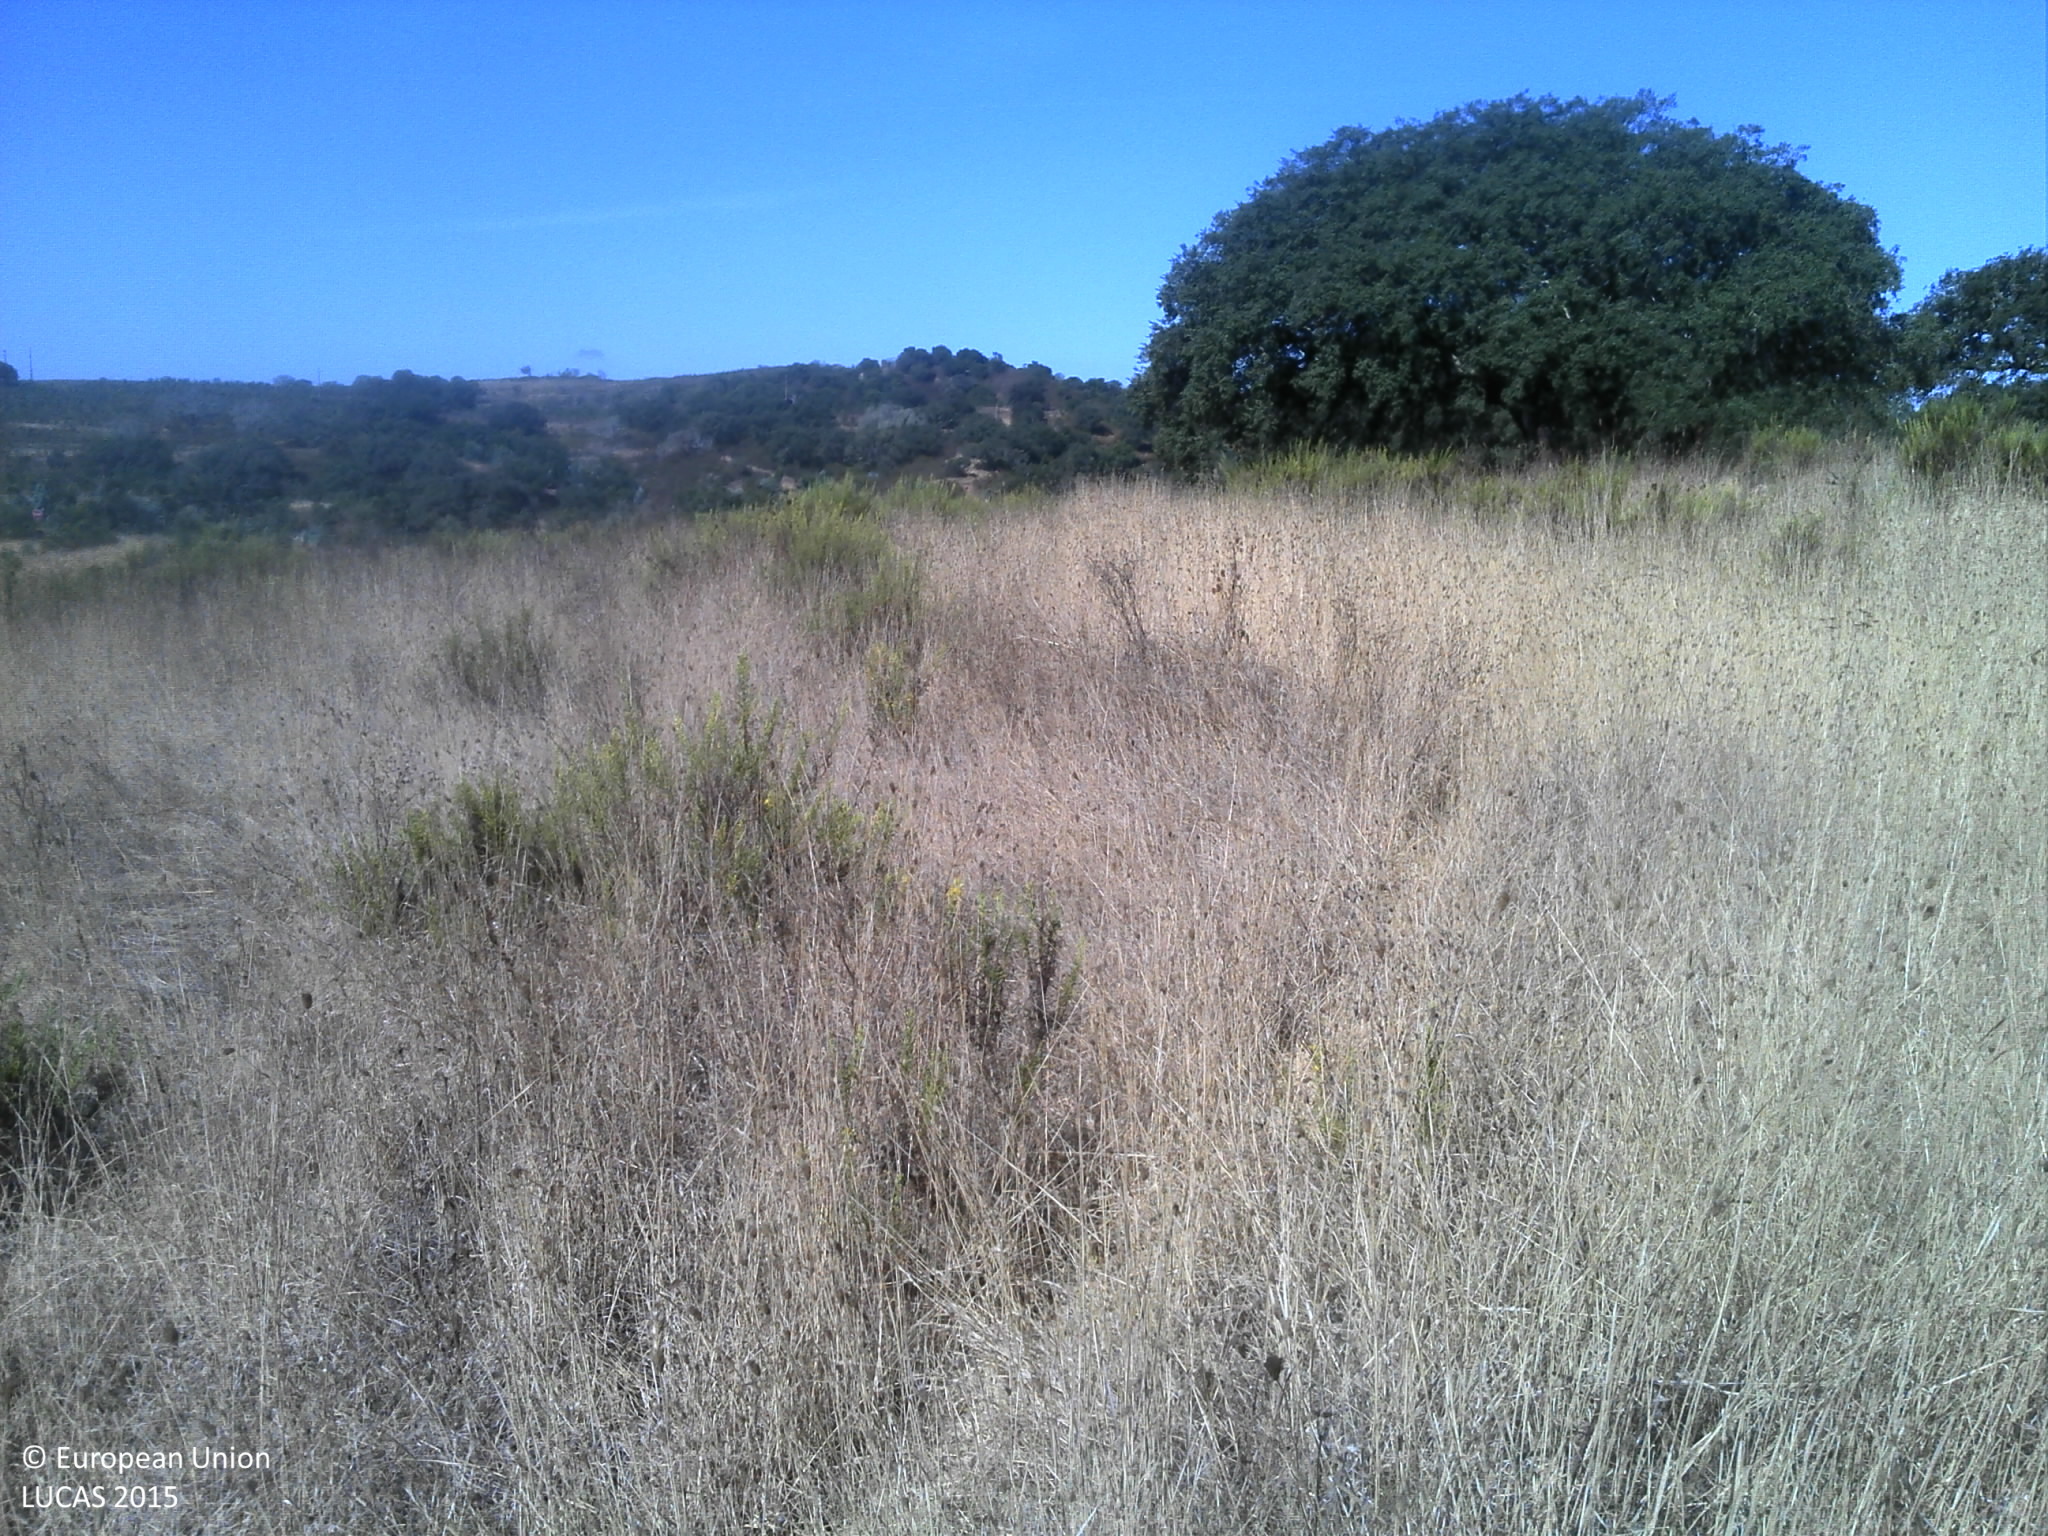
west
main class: Grassland
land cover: Grassland without tree/shrub cover
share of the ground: > 75 %
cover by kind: herbaceous plants 75 %, unconsolidated bare surface 25 %
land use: Agriculture (excluding fallow land and kitchen gardens)
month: August
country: PT
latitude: 37.5561
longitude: -8.4500
